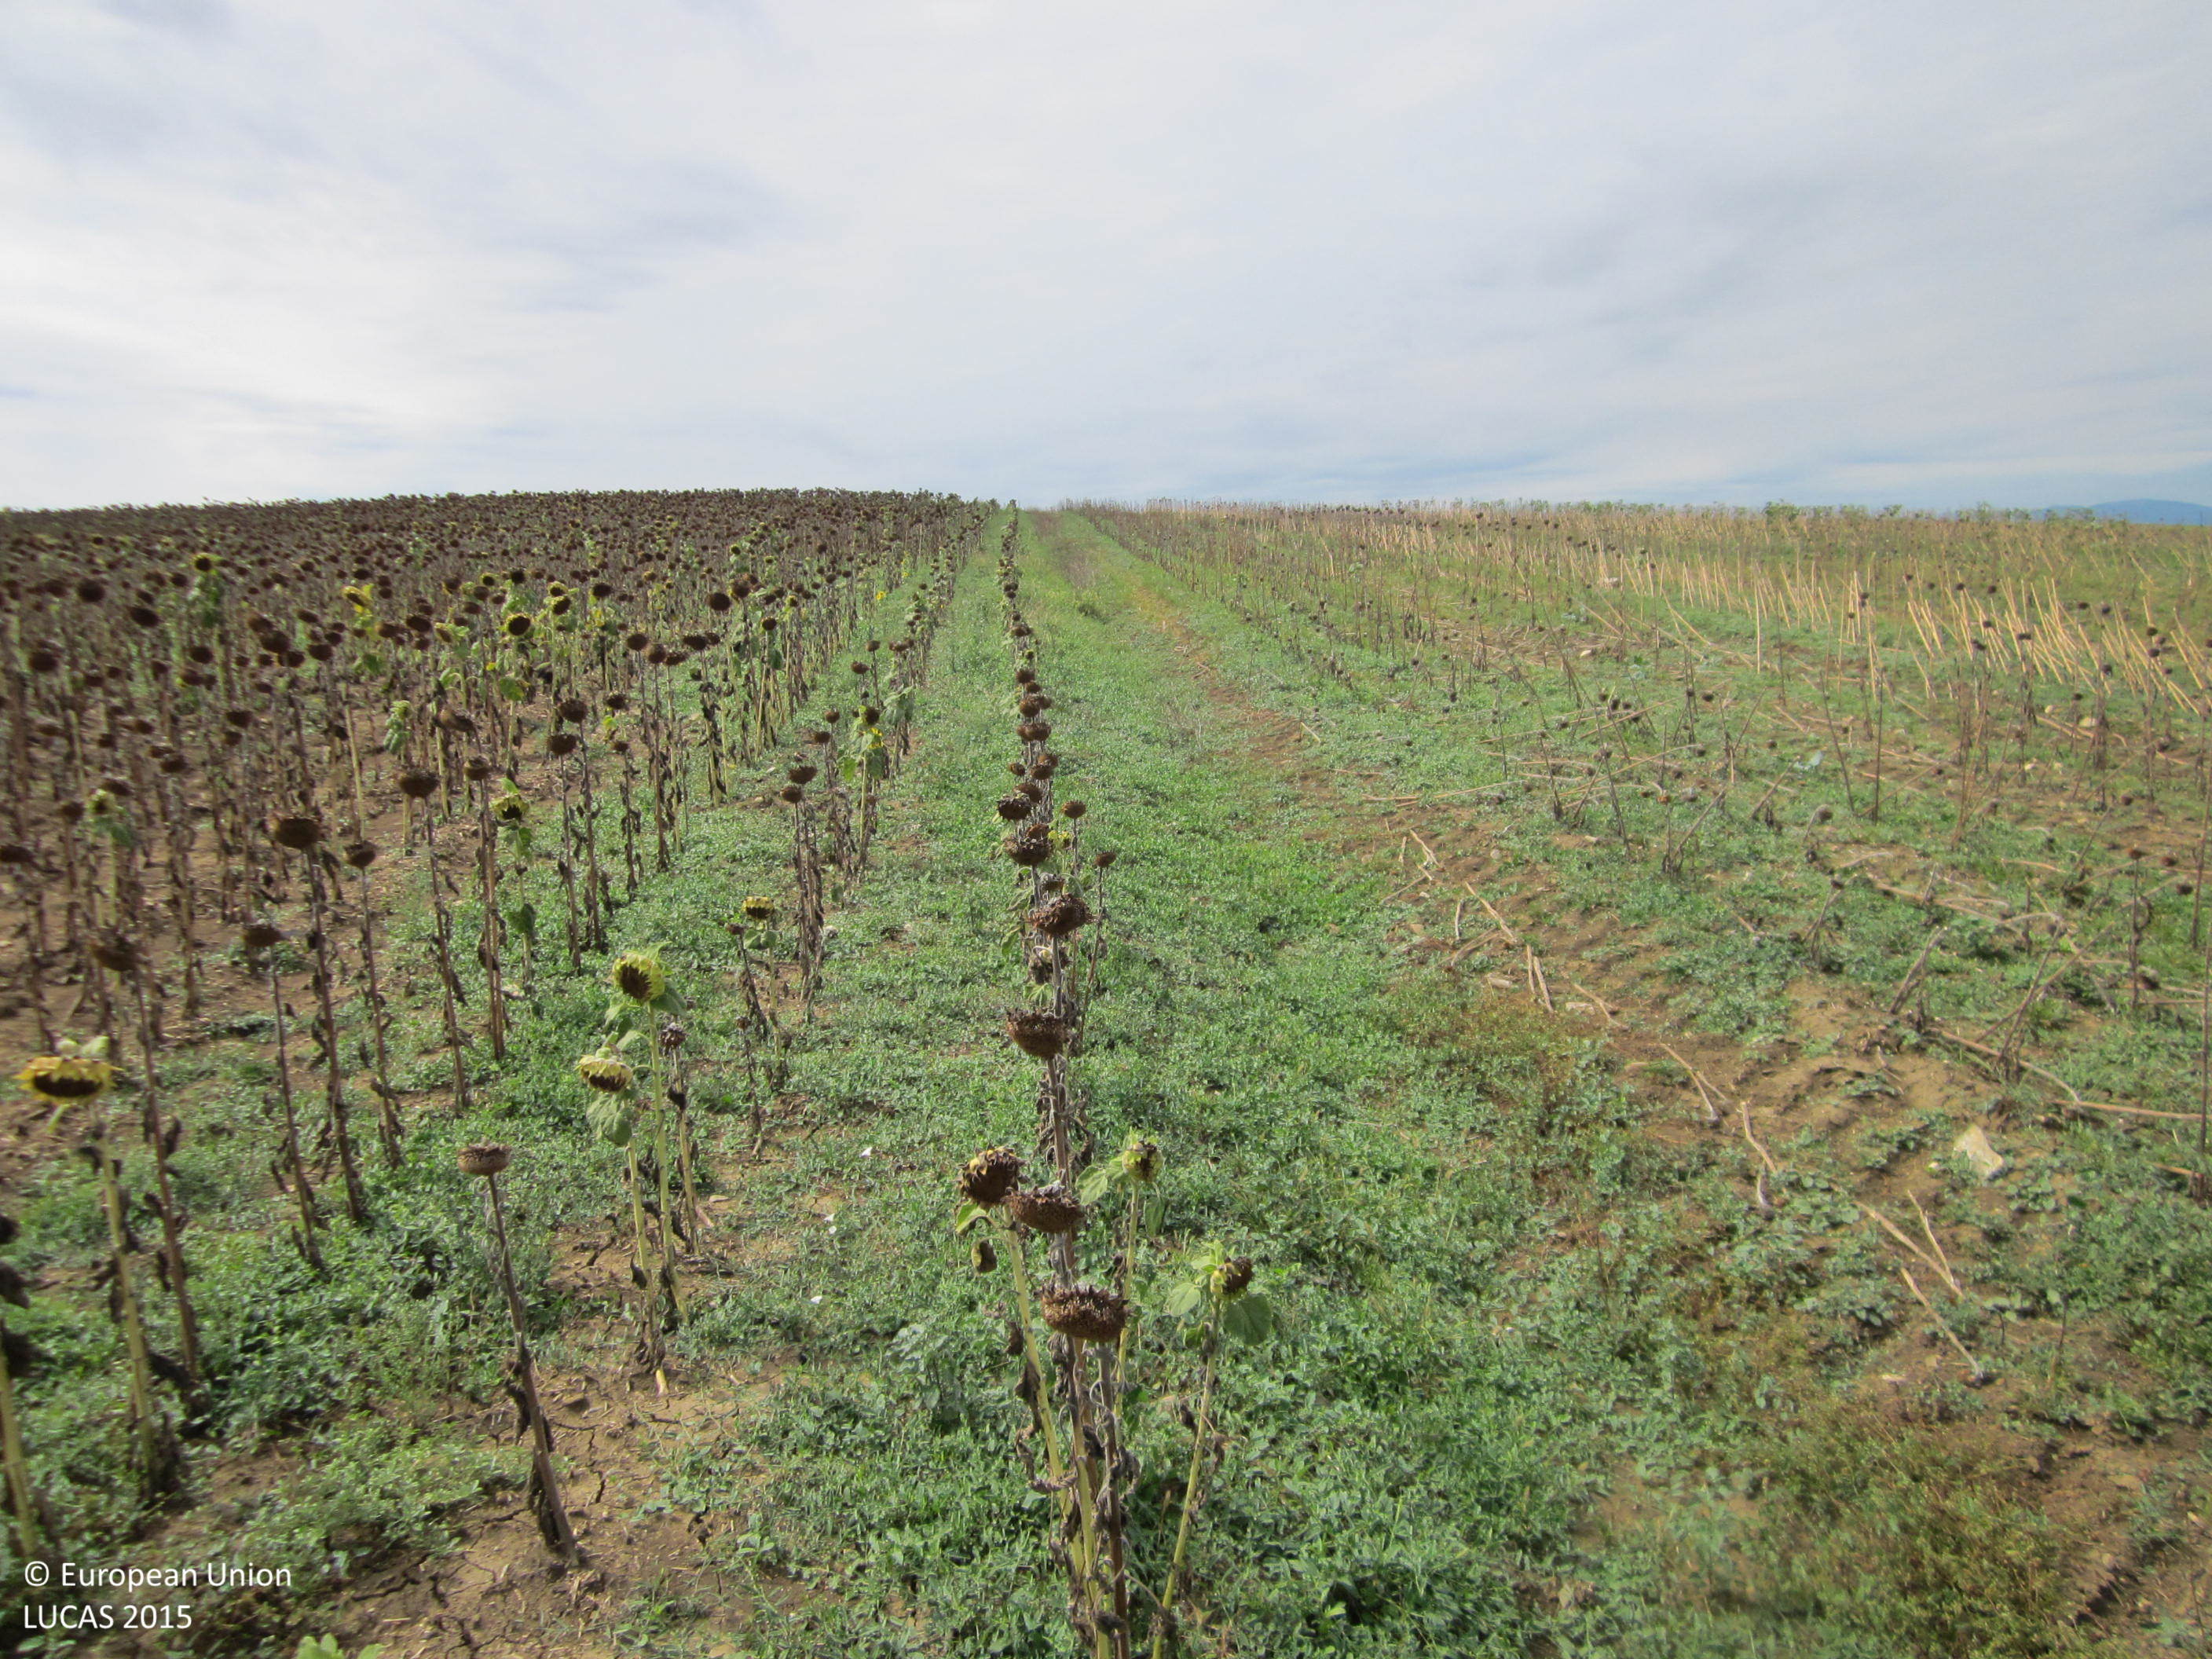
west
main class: Cropland
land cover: Sunflower
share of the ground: 50 - 75 %
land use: Agriculture (excluding fallow land and kitchen gardens)
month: September
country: BG
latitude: 42.6896
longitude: 27.0371
